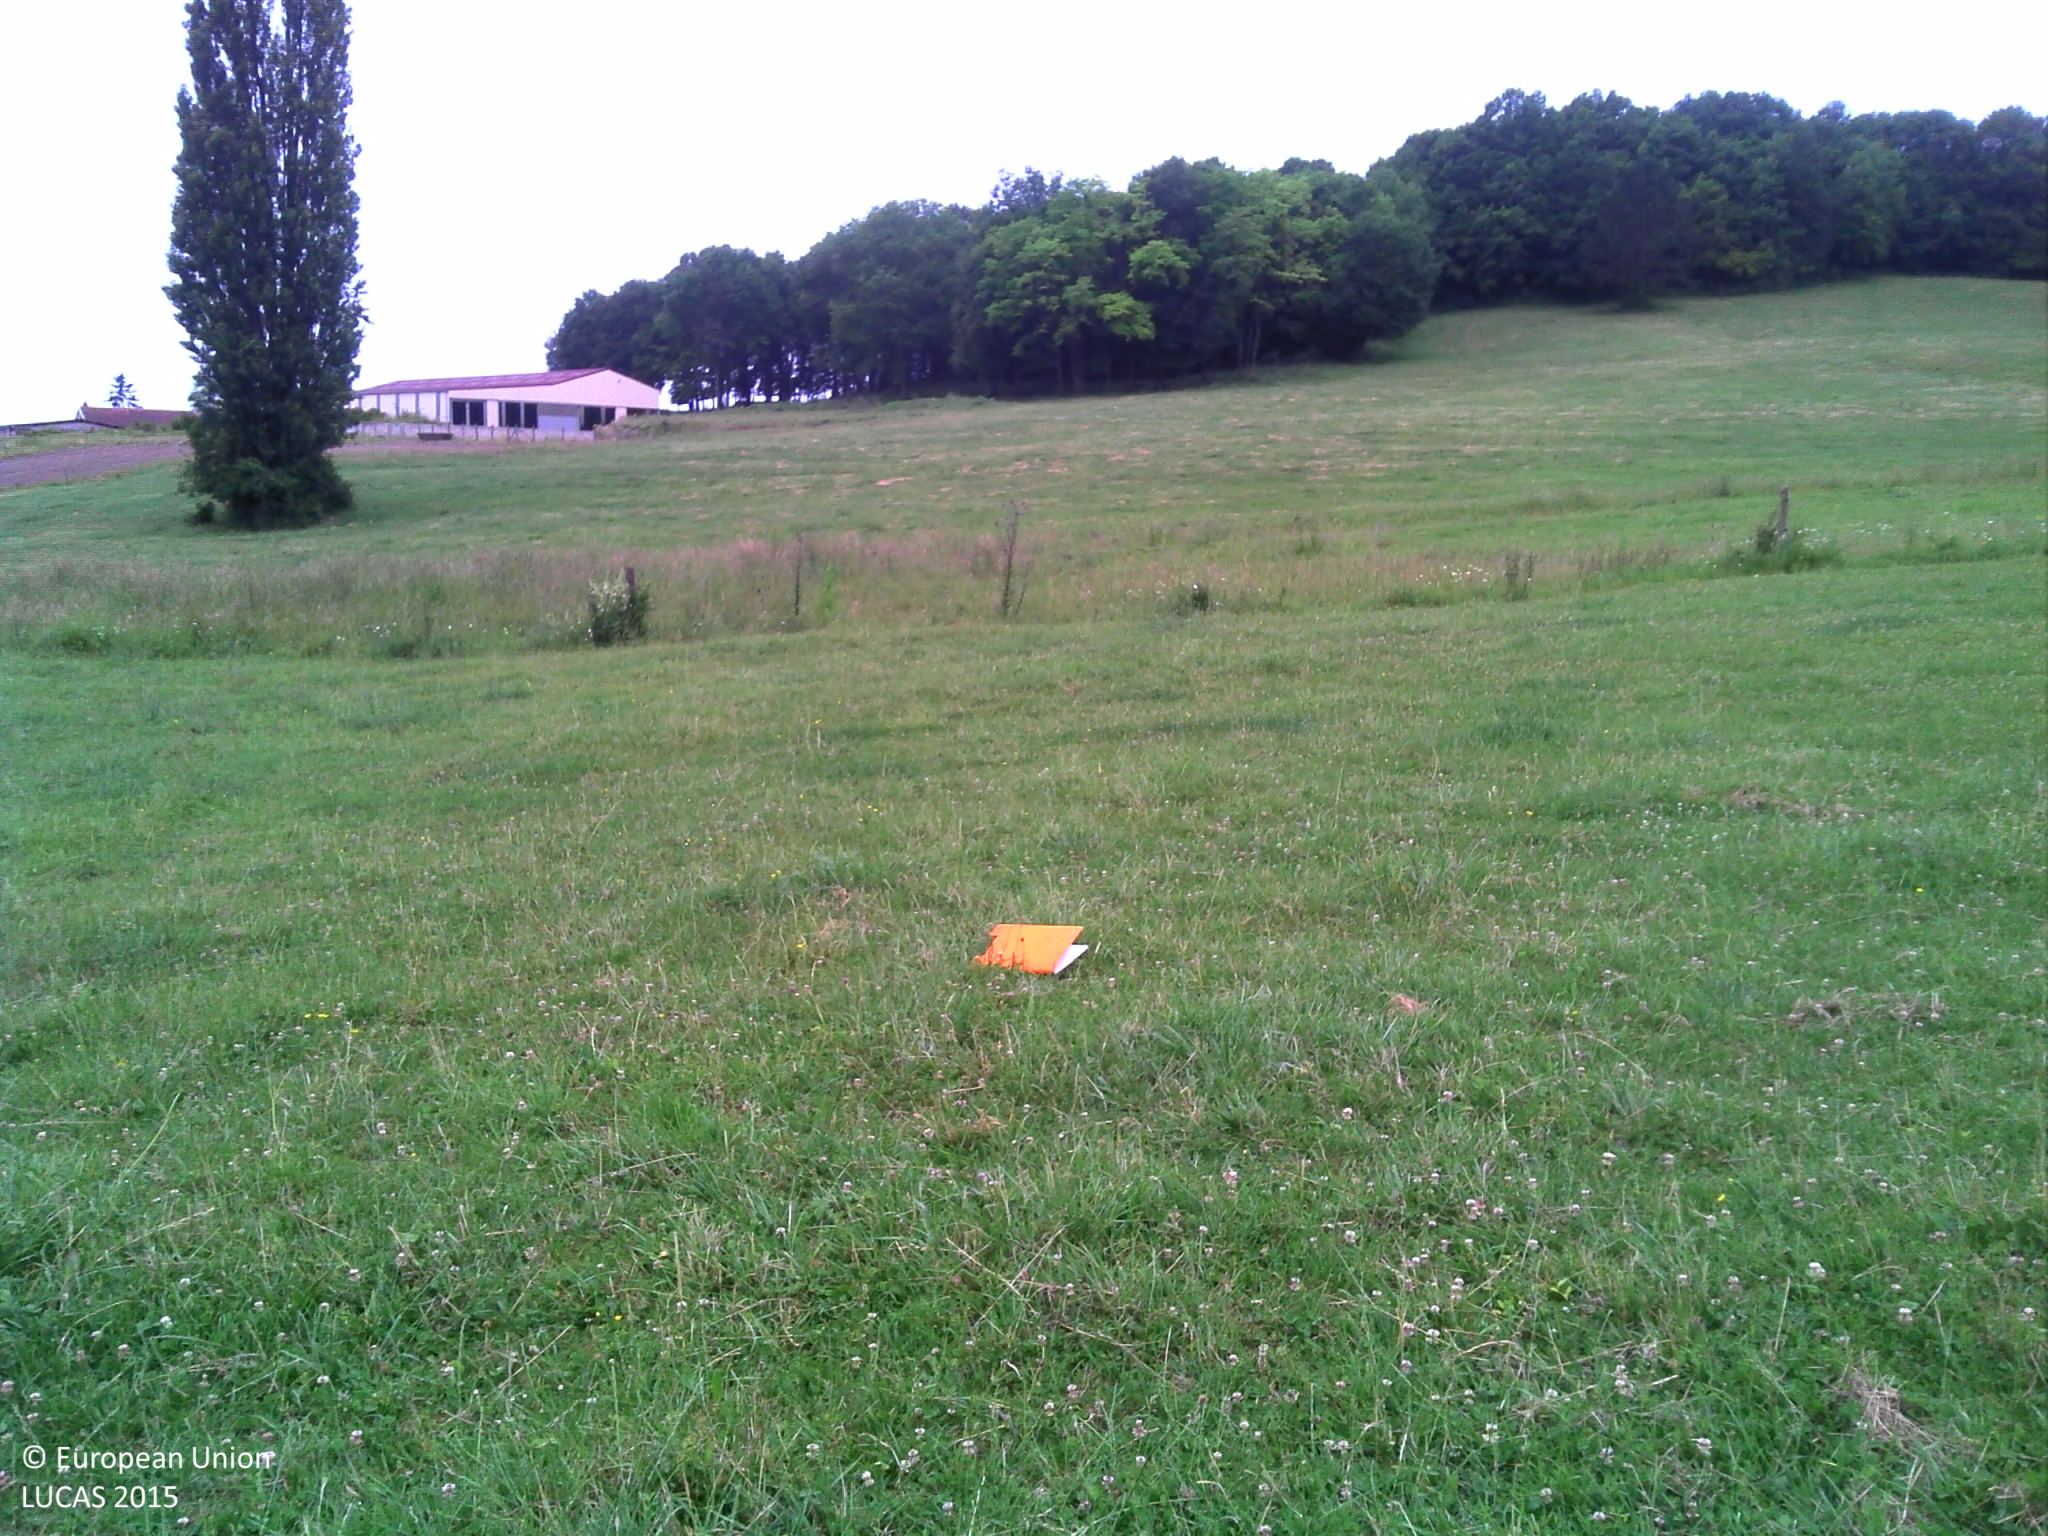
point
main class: Grassland
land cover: Grassland without tree/shrub cover
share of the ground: > 75 %
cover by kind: herbaceous plants 100 %
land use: Agriculture (excluding fallow land and kitchen gardens)
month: June
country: FR
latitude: 47.7303
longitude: 6.3345
